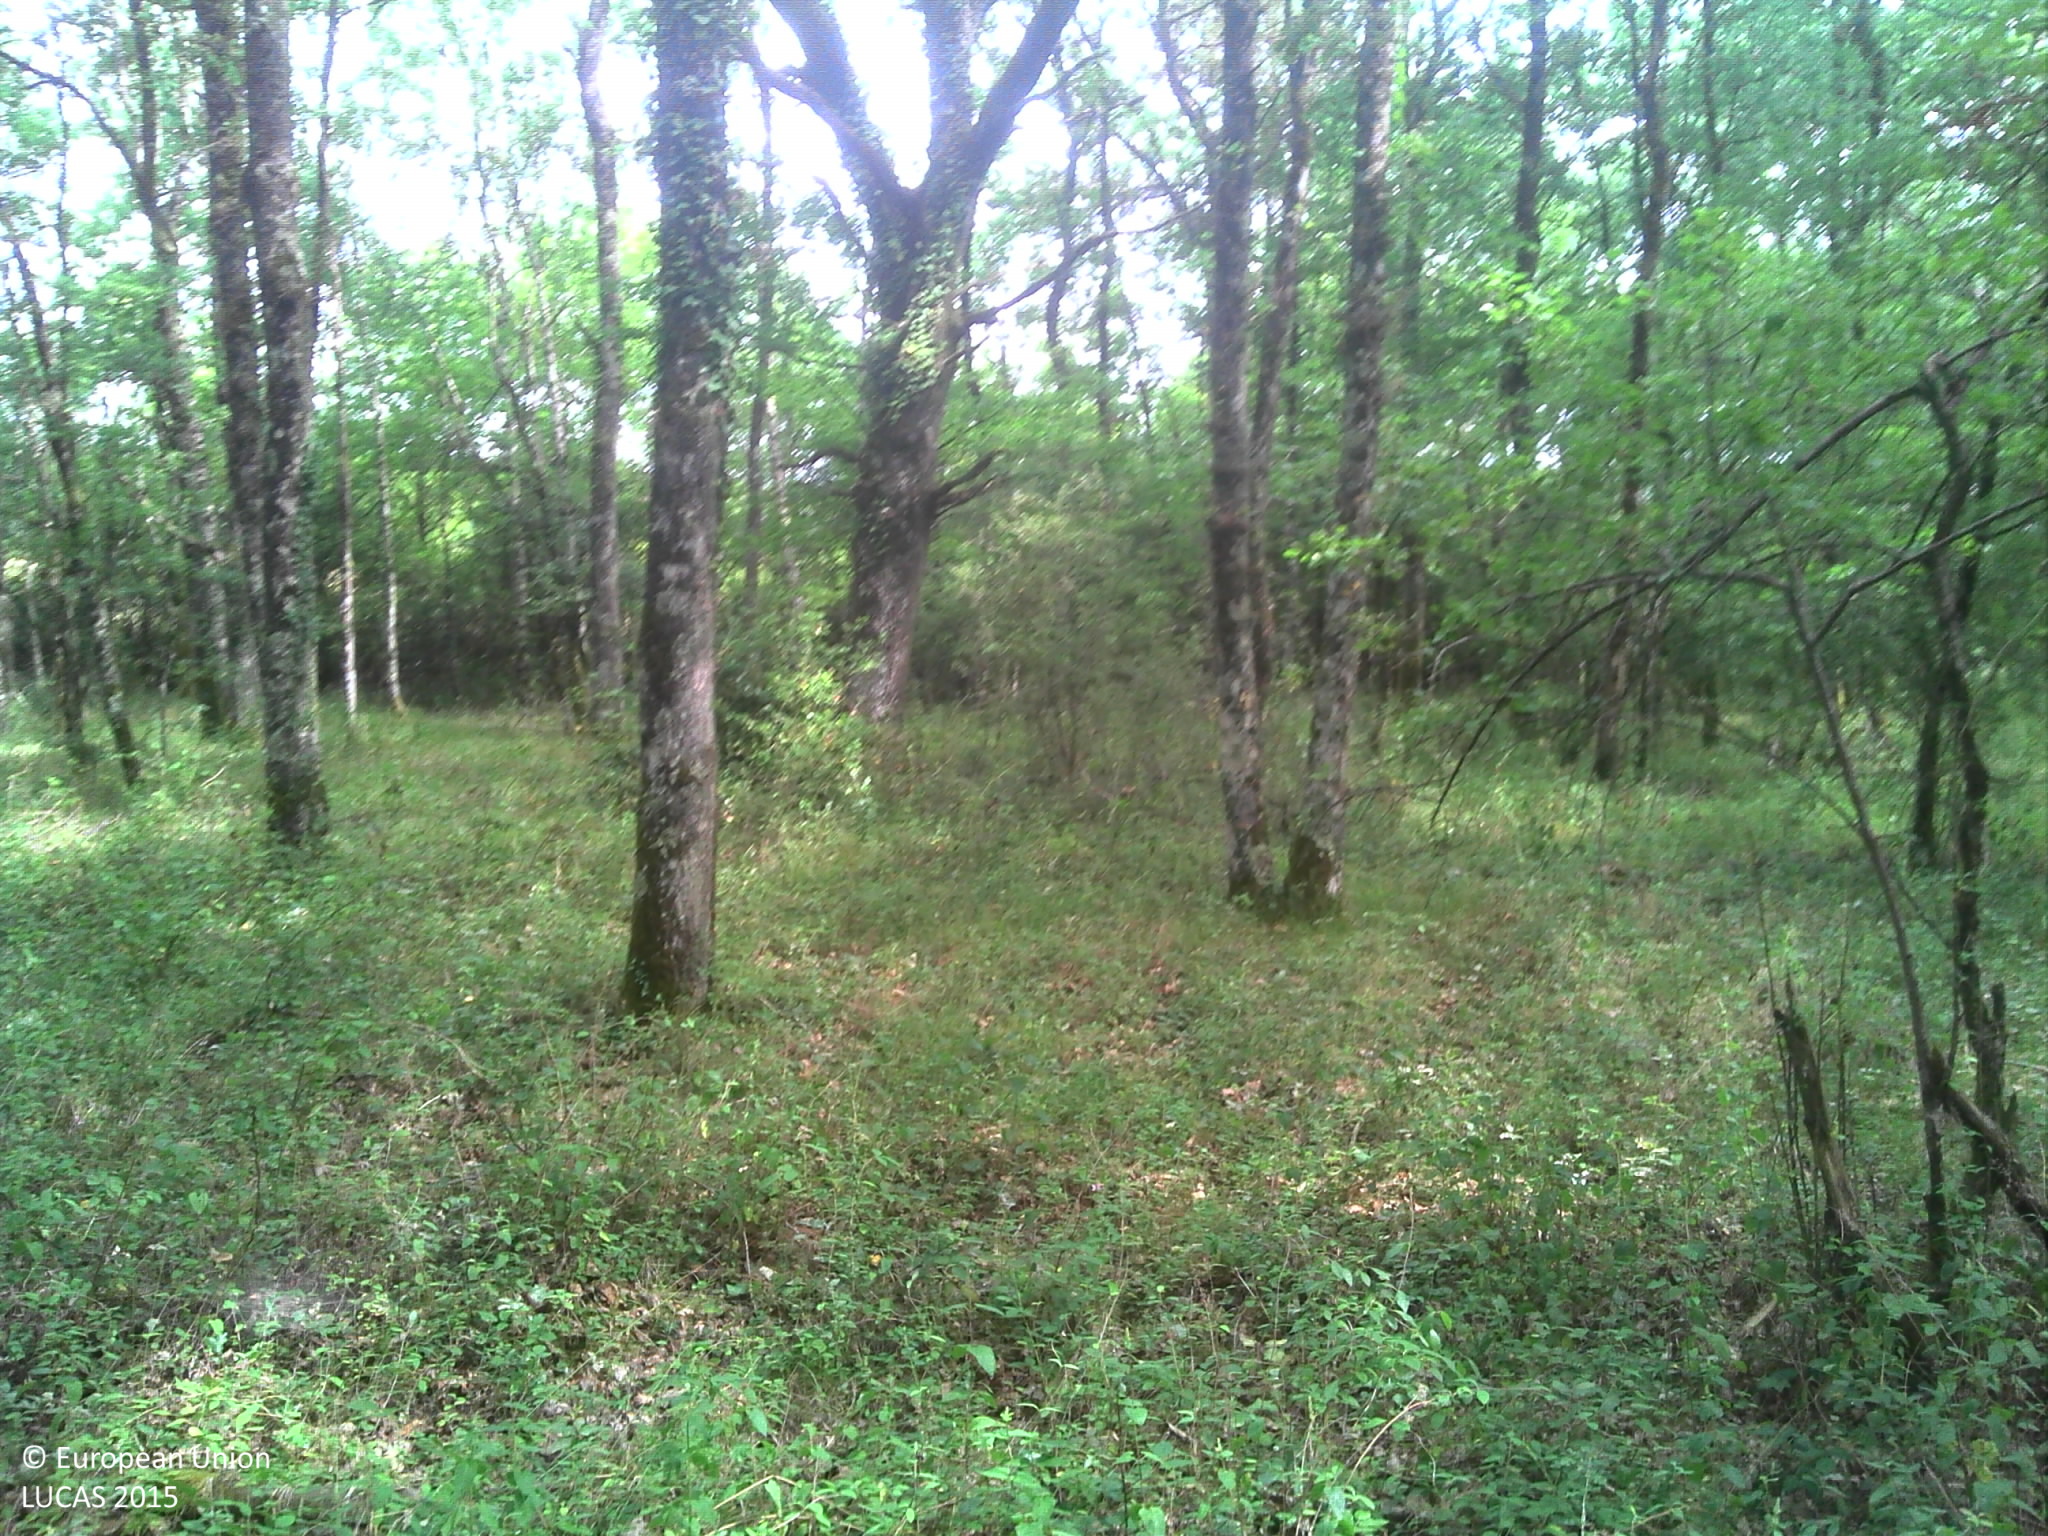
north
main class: Woodland
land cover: Broadleaved woodland
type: mesophytic deciduous forest
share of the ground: > 75 %
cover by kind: herbaceous plants 40 %, unconsolidated bare surface 40 %, broadleaved forest trees 20 %
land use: Forestry
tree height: > 5 m
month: June
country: FR
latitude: 47.3658
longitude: 1.4454
